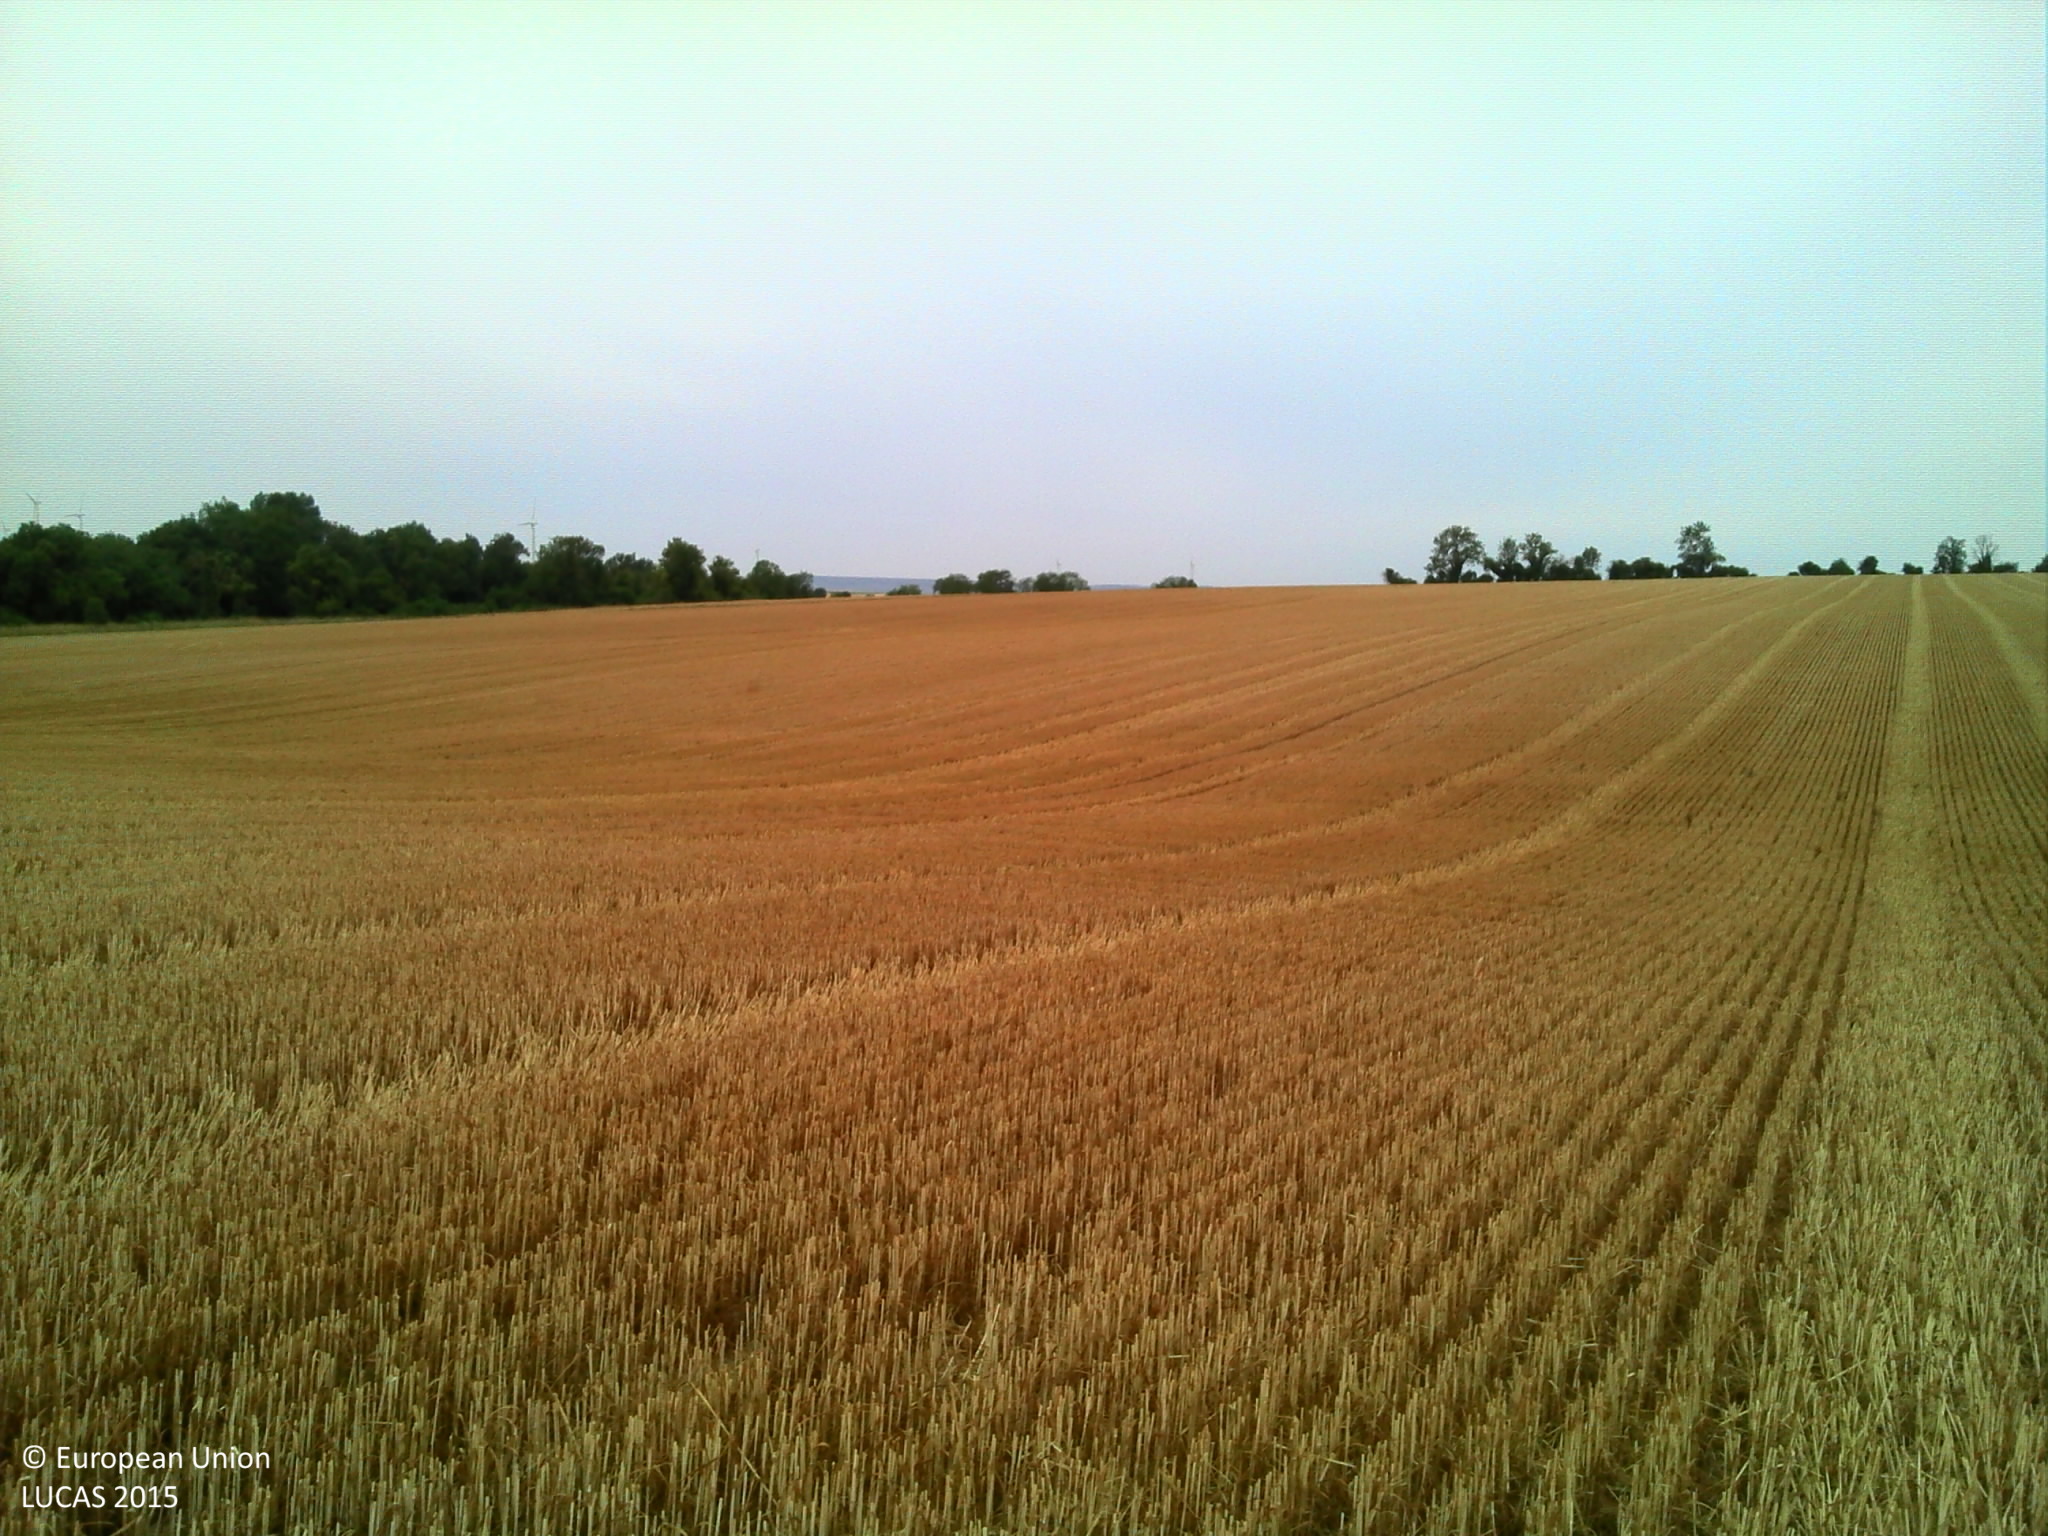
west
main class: Cropland
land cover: Common wheat
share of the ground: > 75 %
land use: Agriculture (excluding fallow land and kitchen gardens)
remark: Harvested field
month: July
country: FR
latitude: 48.8632
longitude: 4.1752
